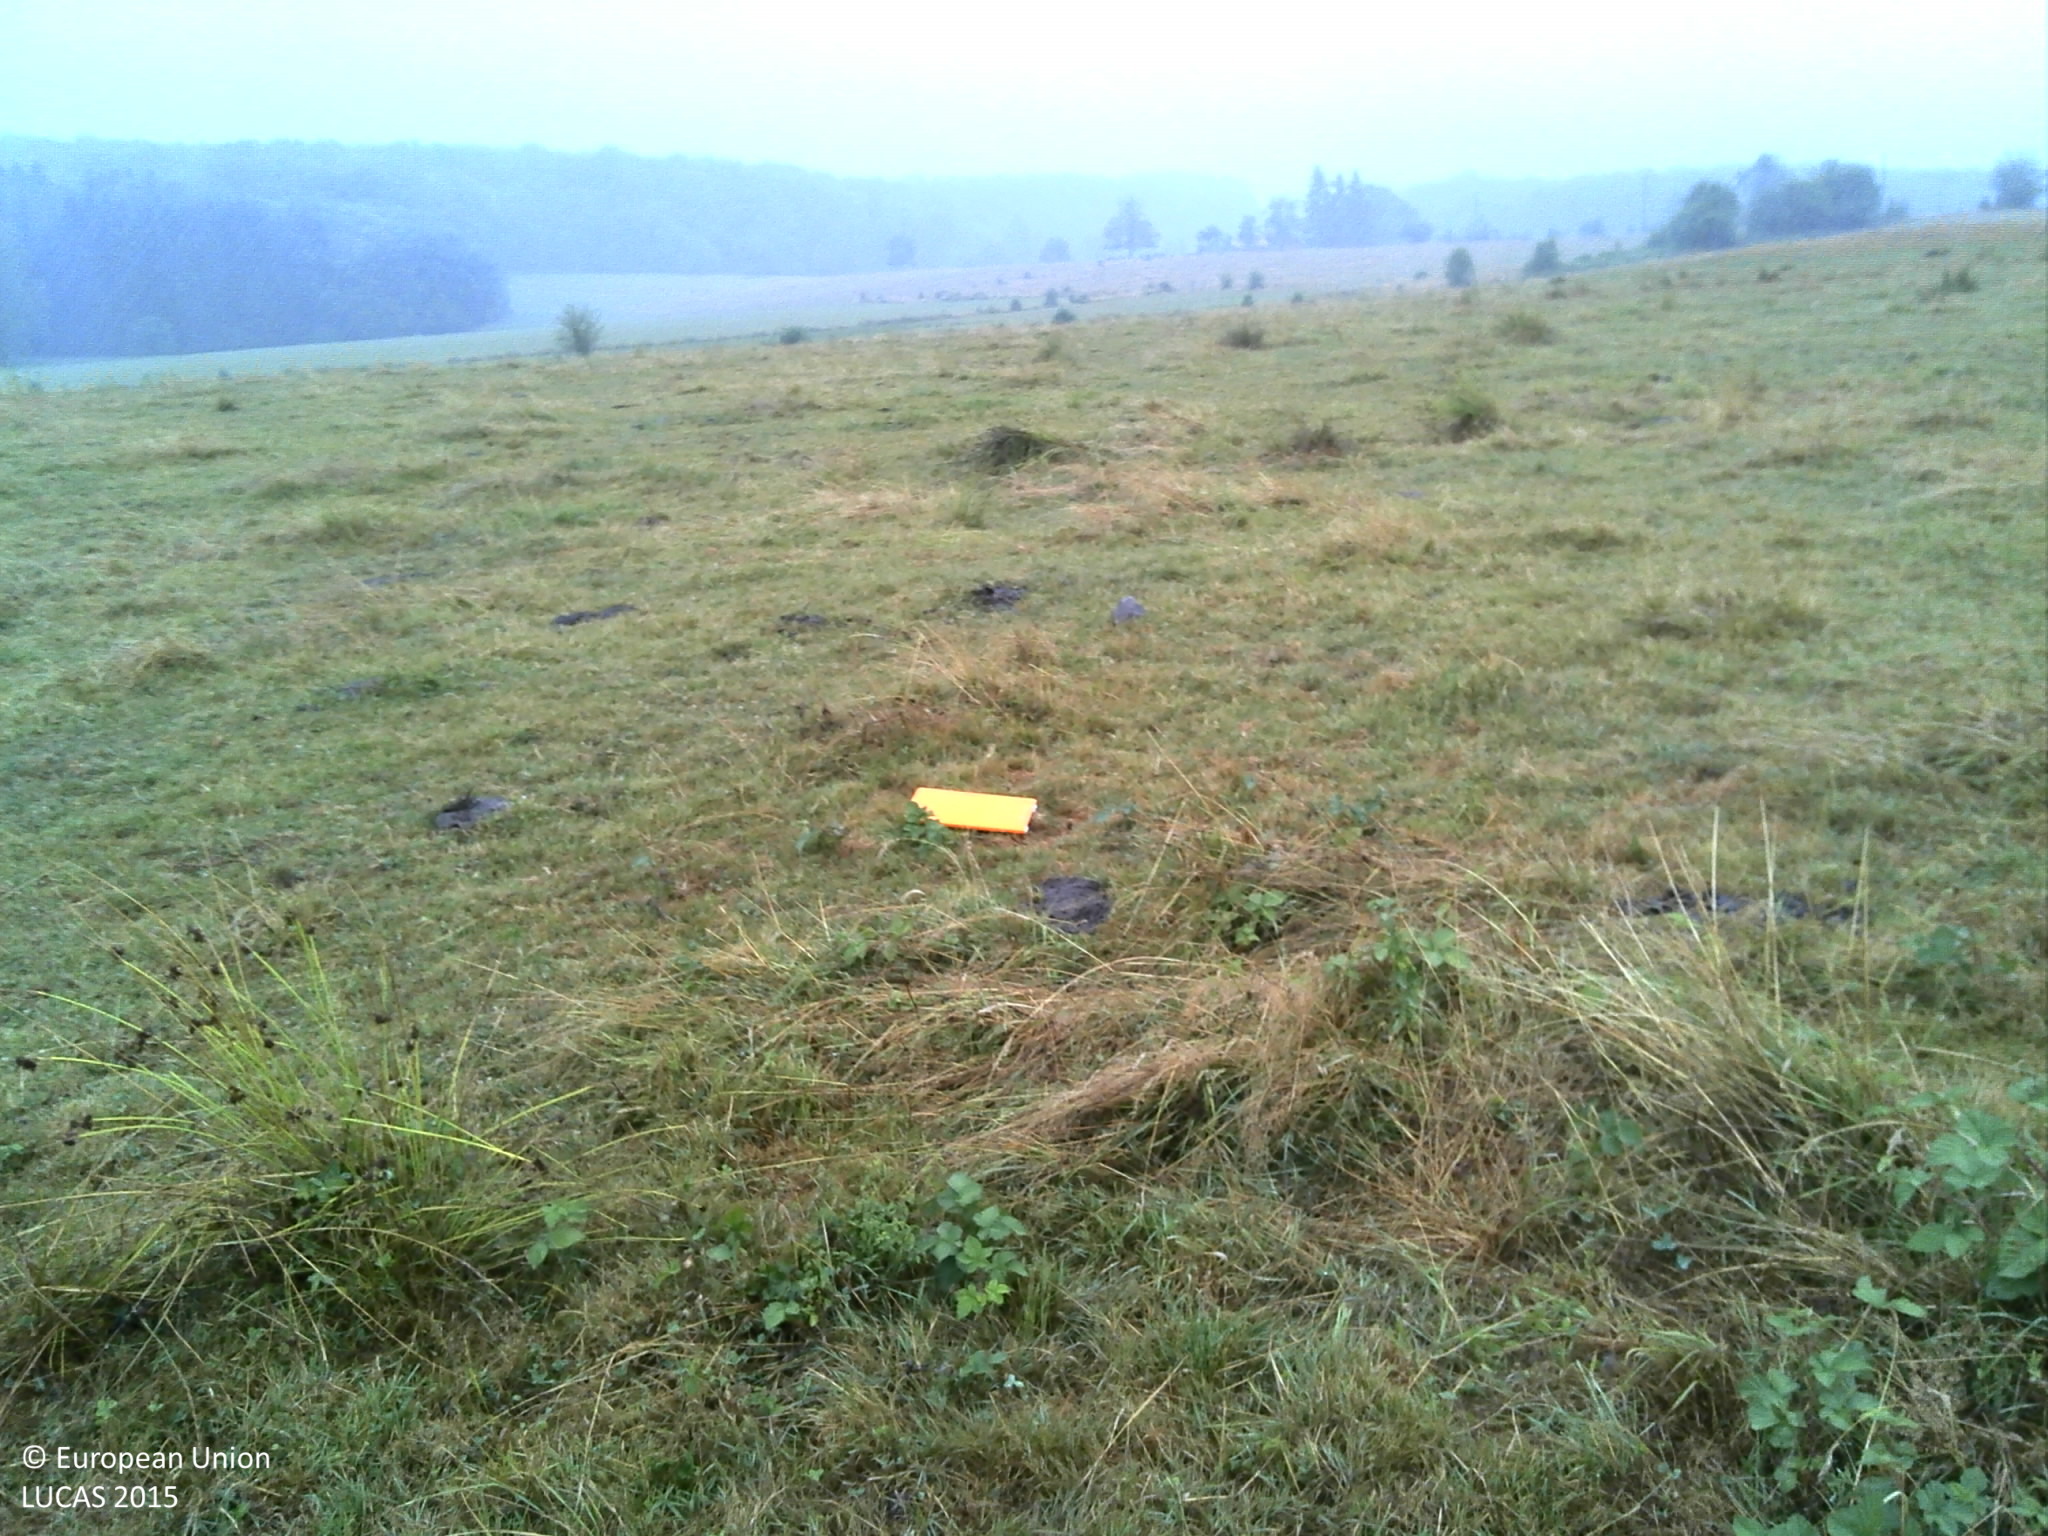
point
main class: Grassland
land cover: Grassland without tree/shrub cover
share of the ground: > 75 %
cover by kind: herbaceous plants 100 %
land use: Agriculture (excluding fallow land and kitchen gardens)
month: July
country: FR
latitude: 47.9621
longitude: 6.2643
